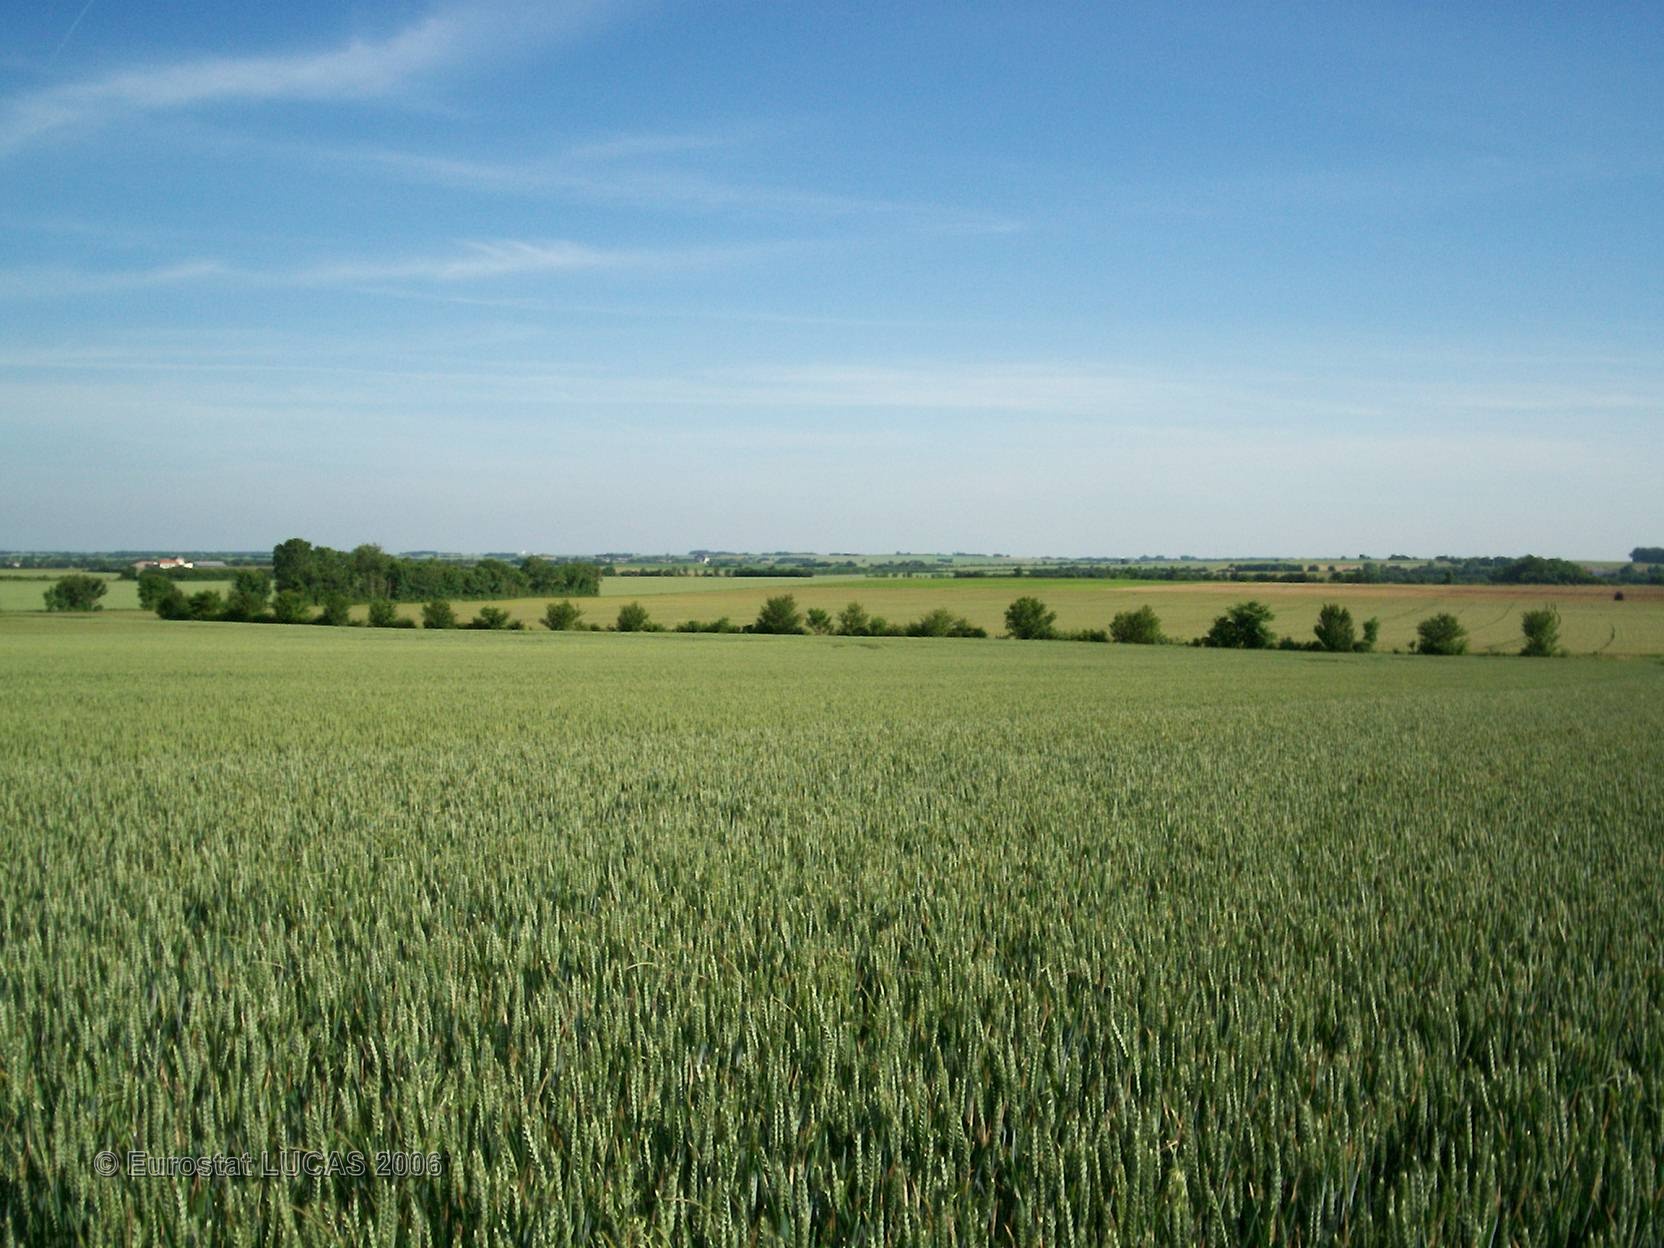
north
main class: Cropland
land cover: Common wheat
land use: Agriculture (excluding fallow land and kitchen gardens)
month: June
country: FR
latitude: 46.0680
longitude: -0.6922
